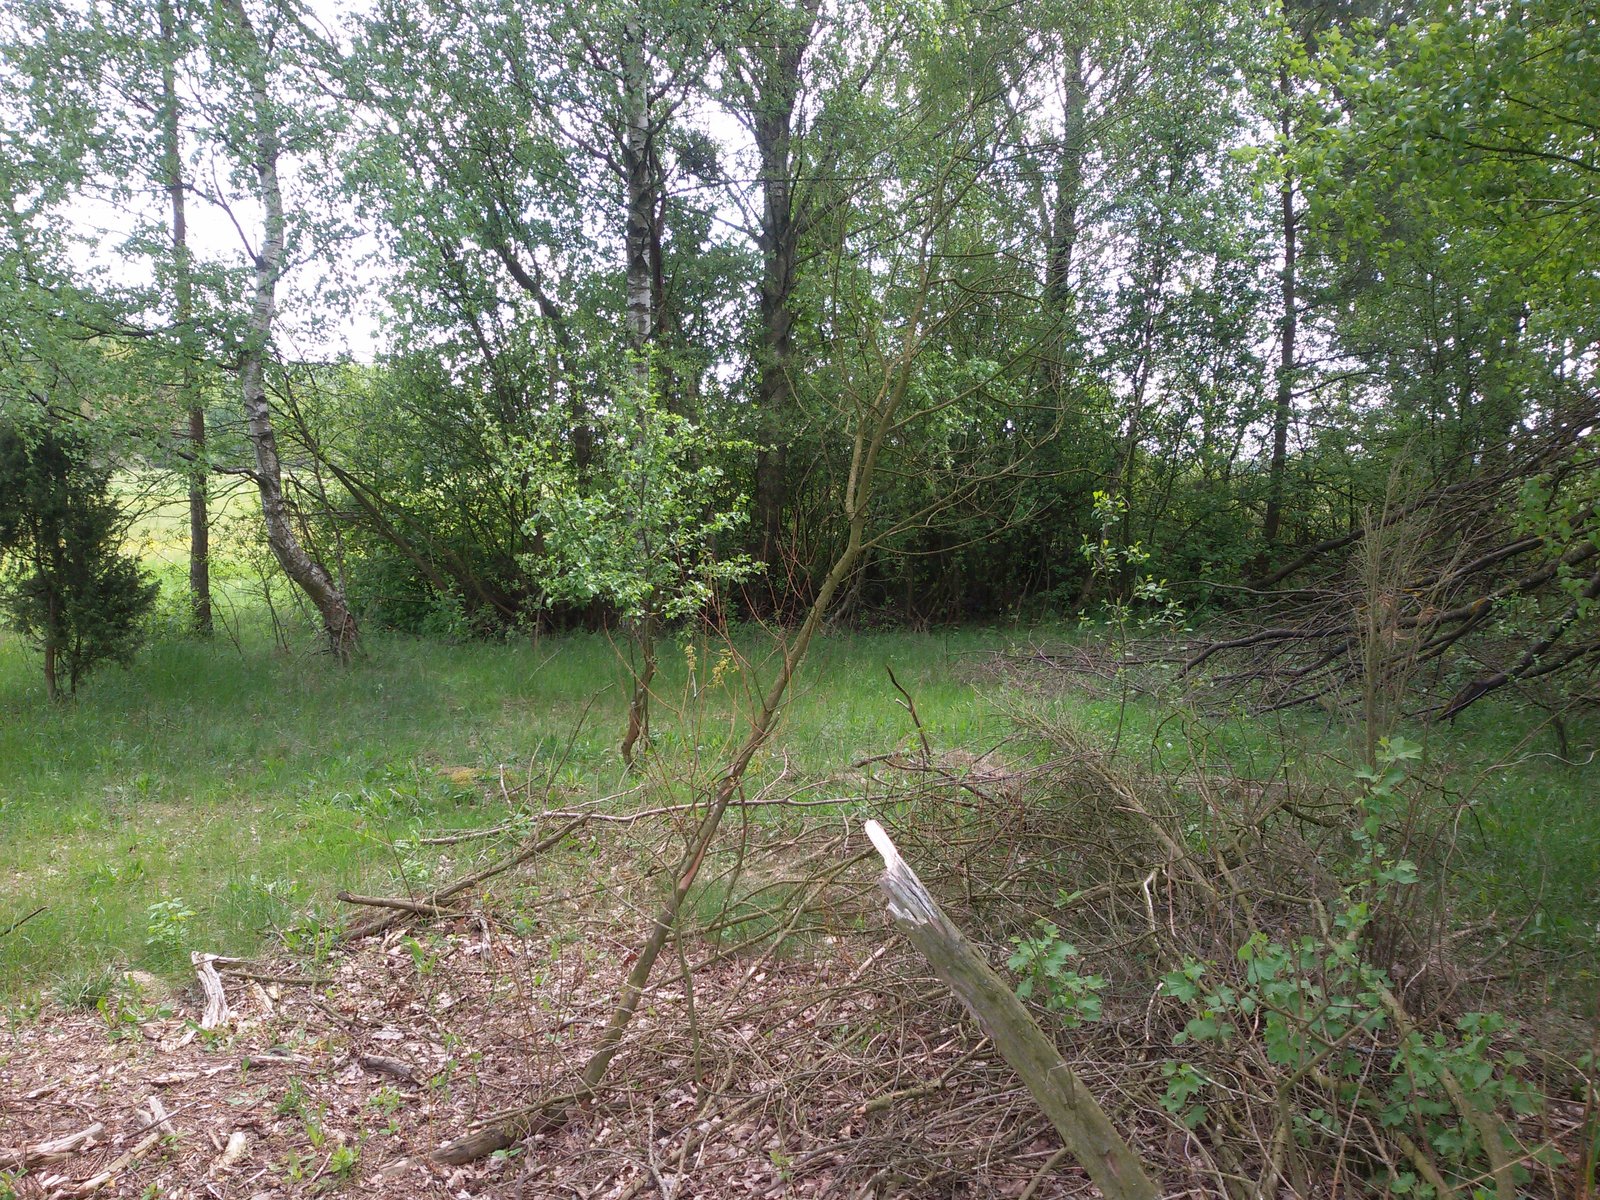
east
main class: Woodland
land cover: Pine dominated mixed woodland
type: hemiboreal forest and nemoral coniferous forest and mixed broadleaved-coniferous forest
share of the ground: > 75 %
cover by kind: coniferous forest trees 60 %, broadleaved forest trees 20 %, herbaceous plants 20 %
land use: Forestry
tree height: > 5 m
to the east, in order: Pine dominated mixed woodland; Grassland without tree/shrub cover; Tracks; Grassland without tree/shrub cover; Tracks; Grassland without tree/shrub cover; Ditches and canals; Grassland without tree/shrub cover
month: May
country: PL
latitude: 53.1523
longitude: 21.3986
